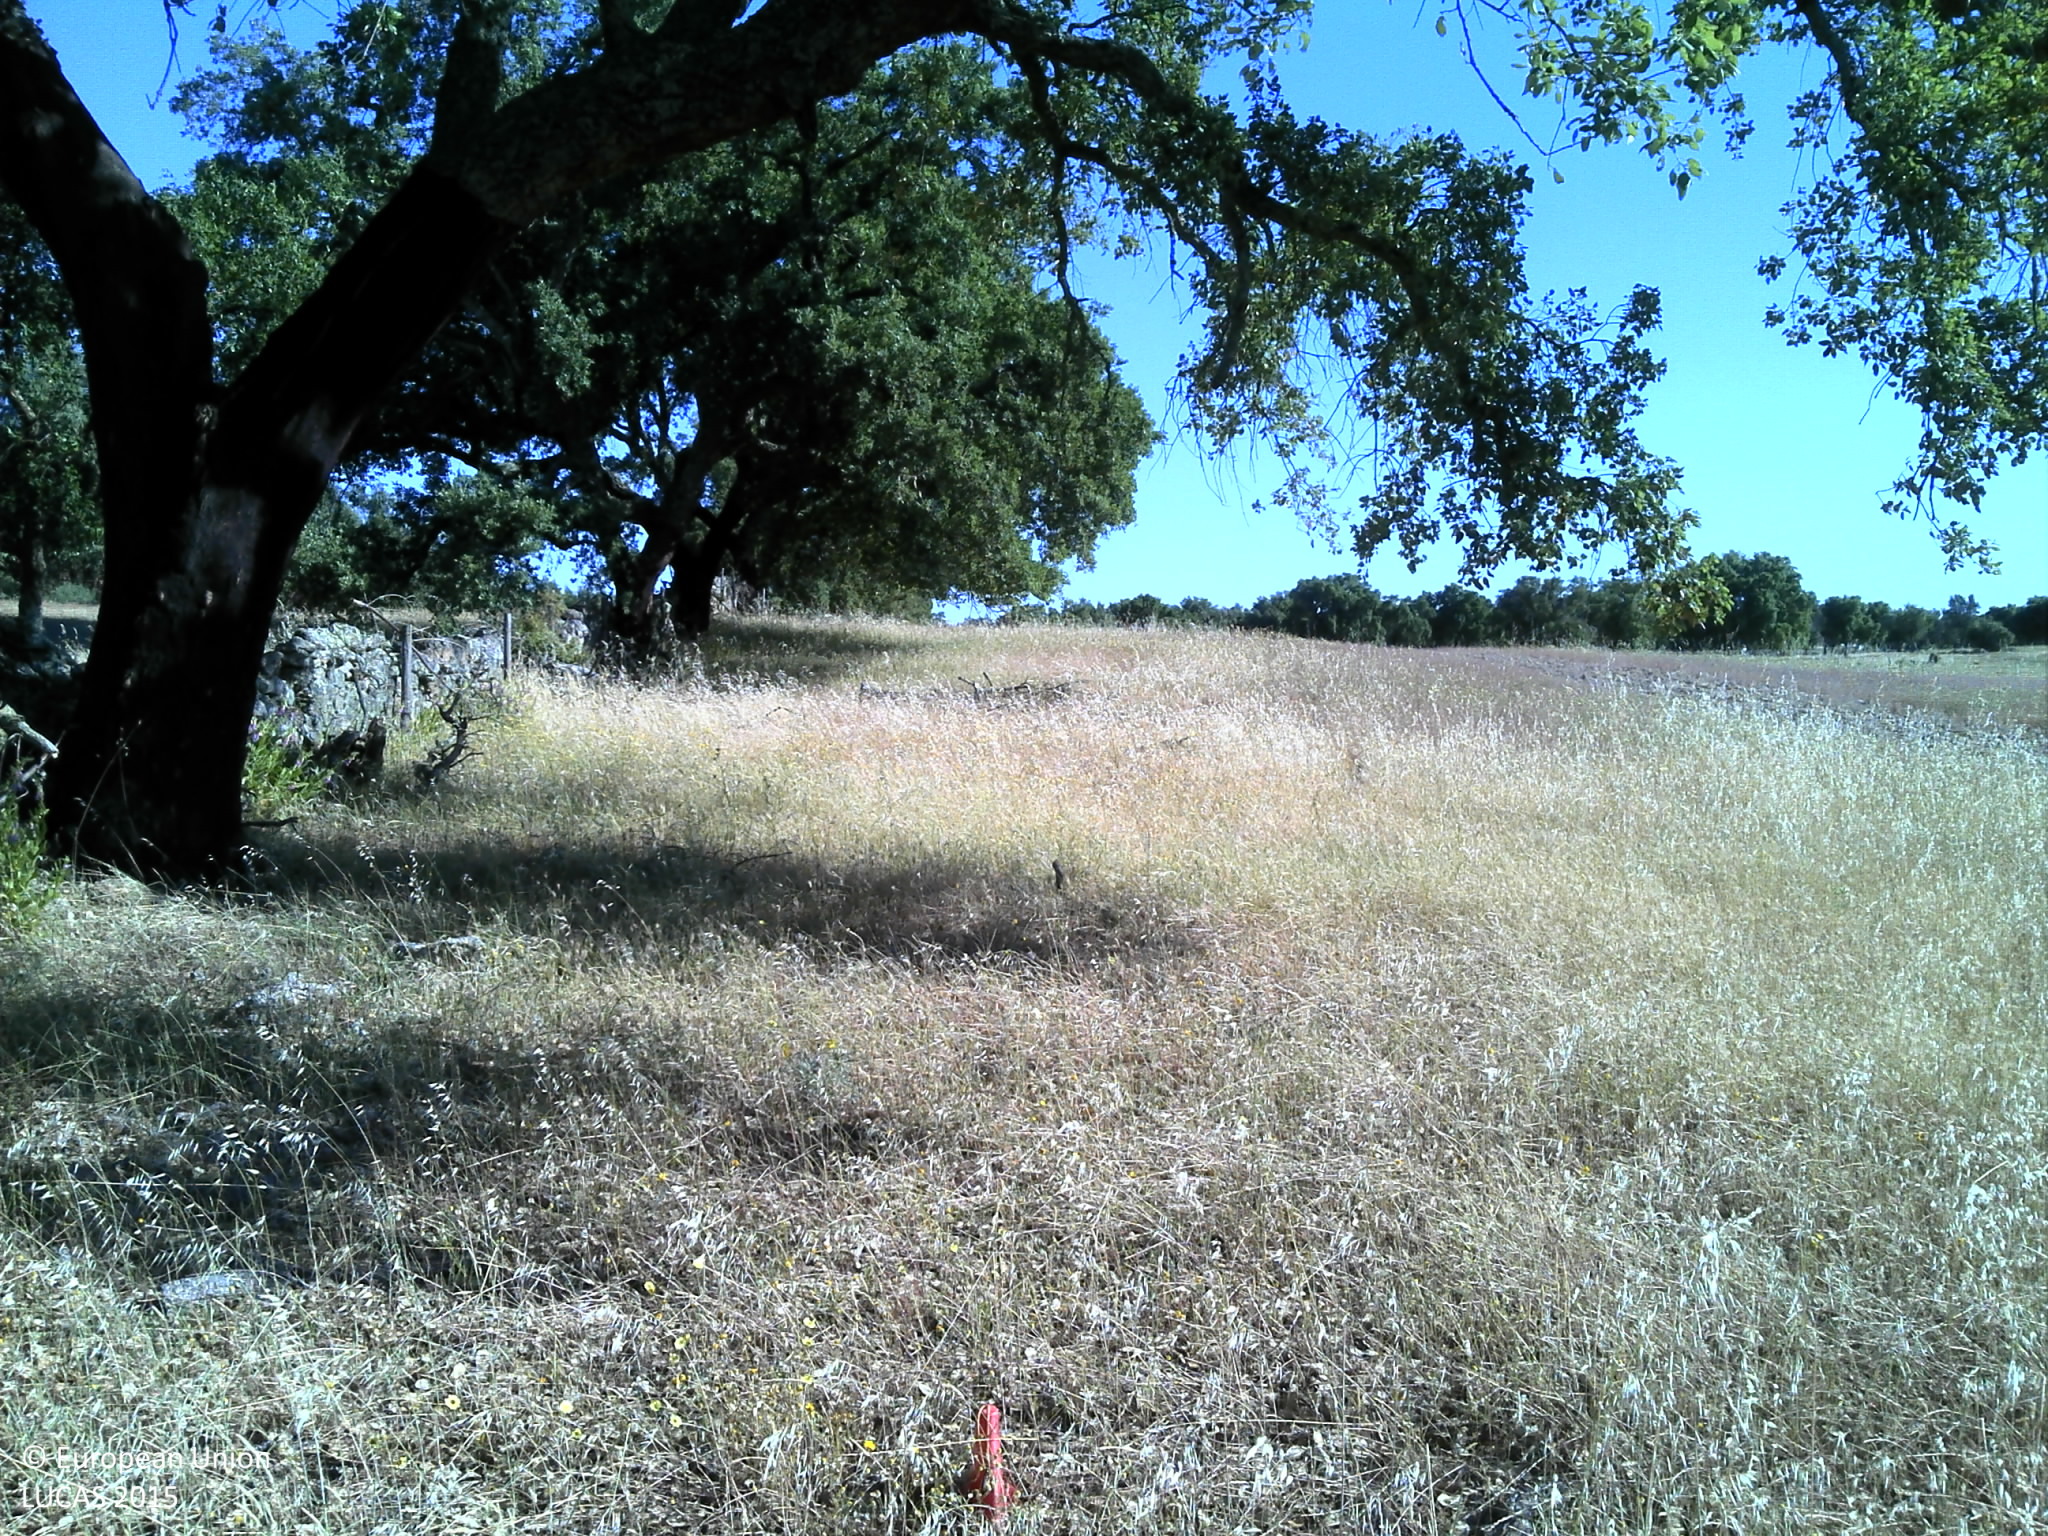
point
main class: Grassland
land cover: Grassland with sparse tree/shrub cover
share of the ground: 50 - 75 %
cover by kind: herbaceous plants 75 %, unconsolidated bare surface 20 %, broadleaved forest trees 5 %
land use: Agriculture (excluding fallow land and kitchen gardens)
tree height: > 5 m
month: May
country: PT
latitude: 39.3977
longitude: -7.6167
